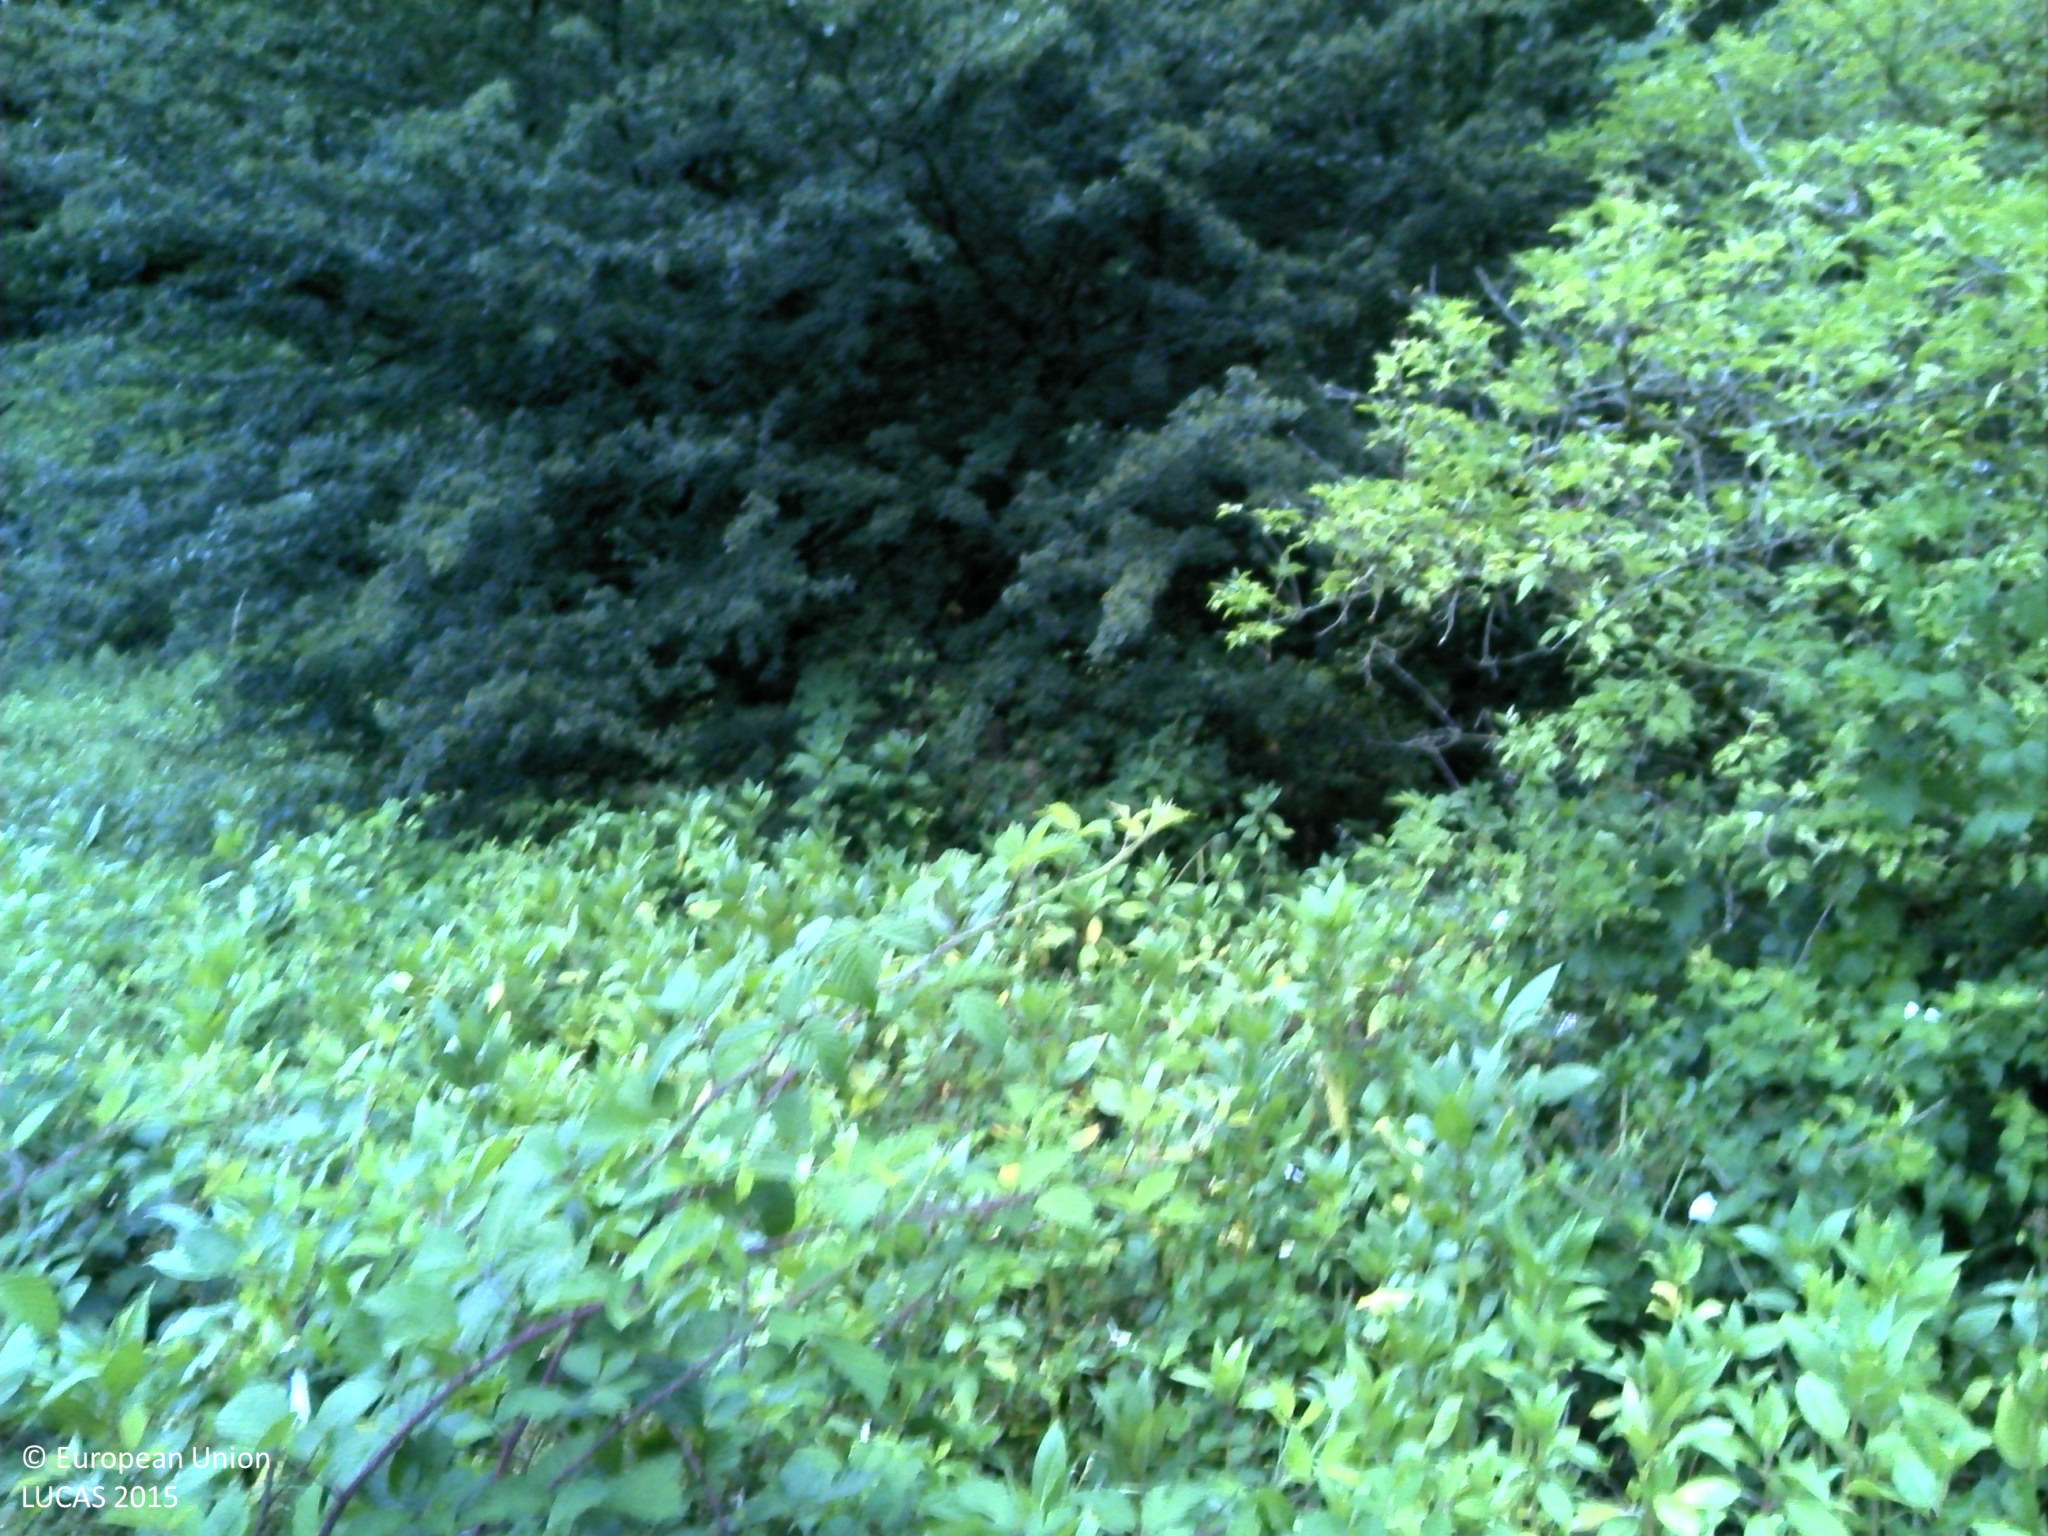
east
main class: Shrubland
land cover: Shrubland with sparse tree cover
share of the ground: > 75 %
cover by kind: shrubs 95 %, broadleaved forest trees 5 %
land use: Semi-natural and natural areas not in use
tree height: < 5 m
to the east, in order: Shrubland with sparse tree cover; Broadleaved woodland; Rivers and streams; Spruce dominated mixed woodland; Grassland with sparse tree/shrub cover; Broadleaved woodland; Spruce dominated coniferous woodland
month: July
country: FR
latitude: 48.0520
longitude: 6.2577
